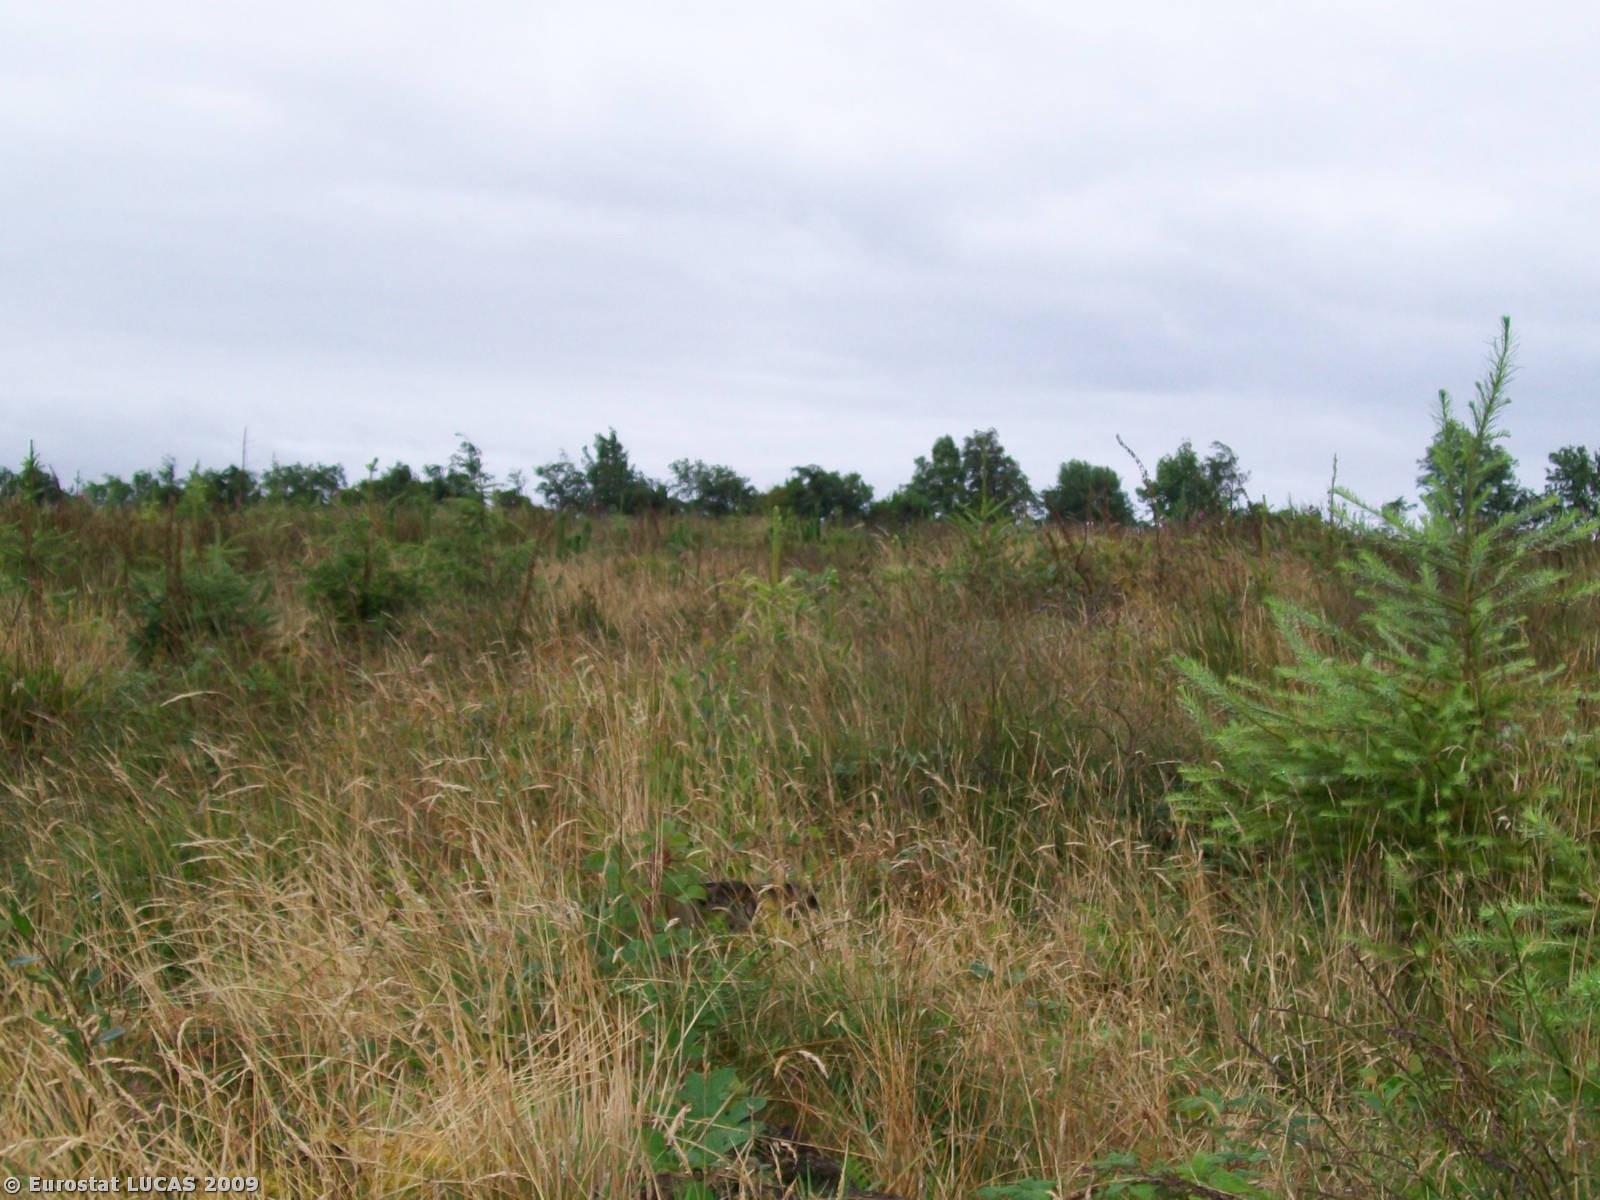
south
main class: Woodland
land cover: Coniferous woodland
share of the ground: > 75 %
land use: Forestry
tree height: < 5 m
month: August
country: IE
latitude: 52.7993
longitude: -9.1286
